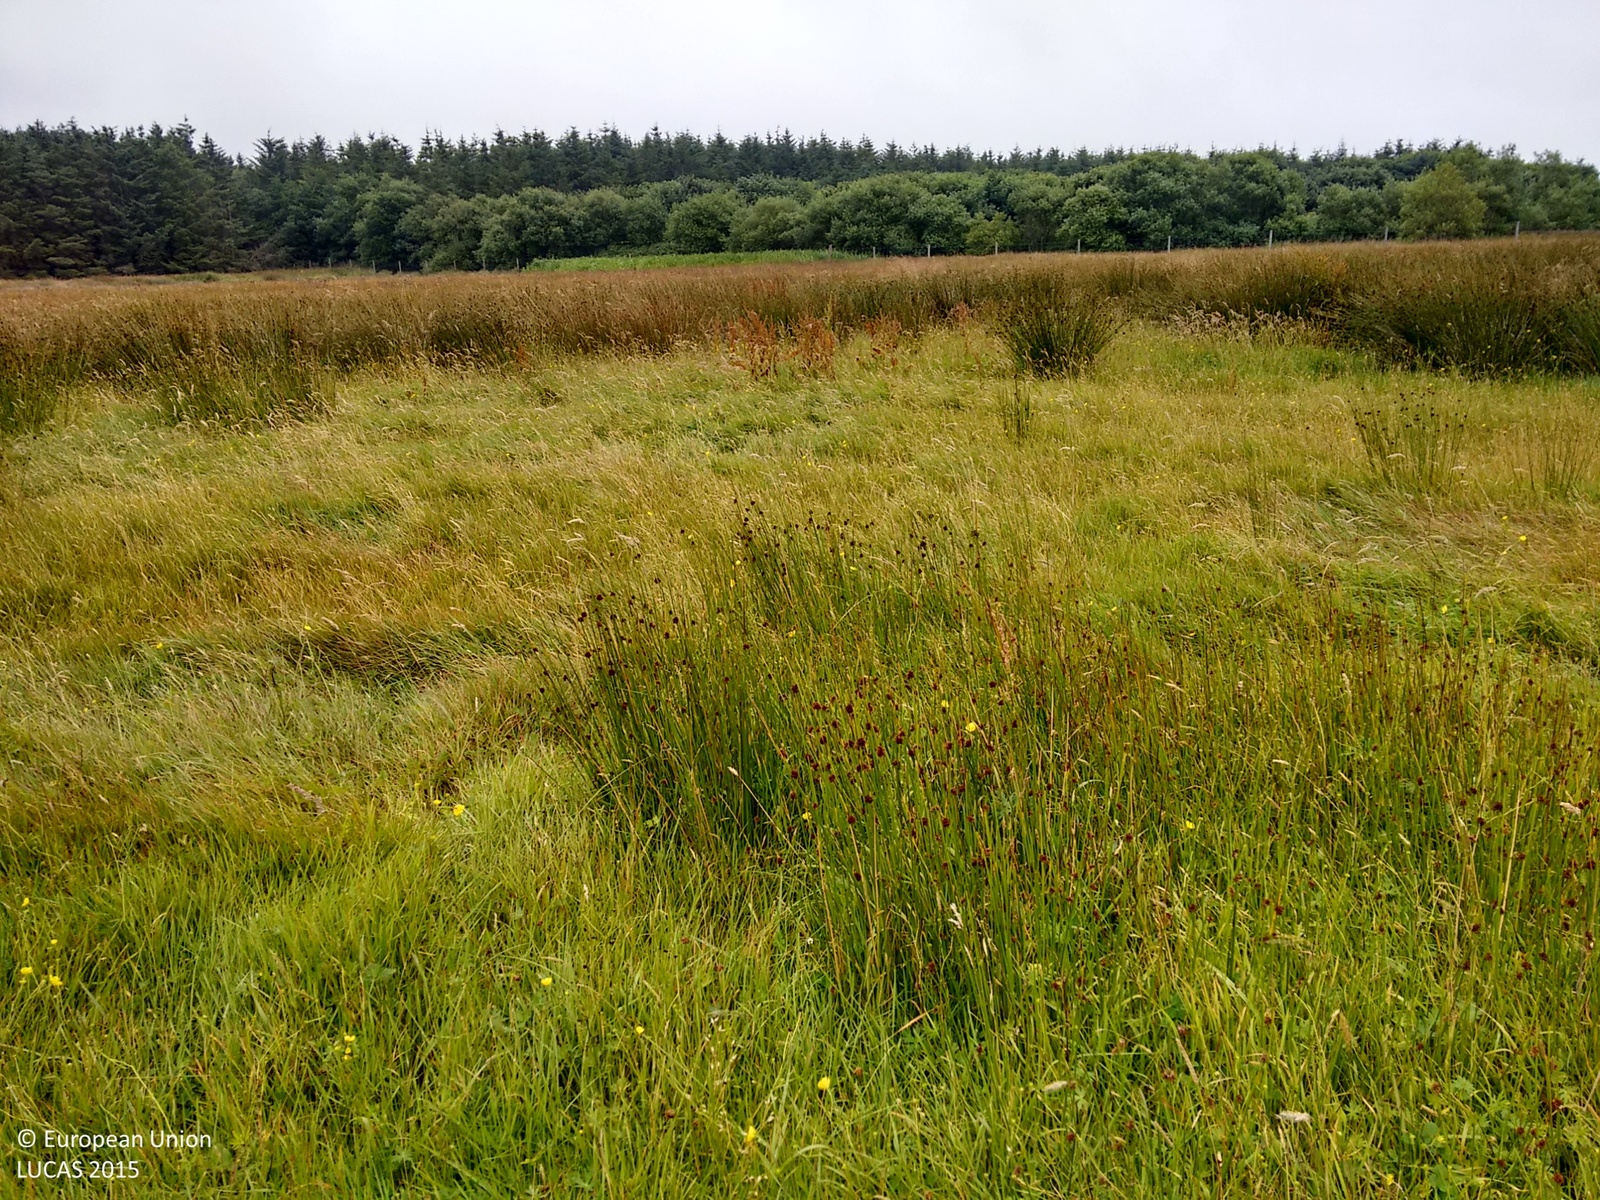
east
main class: Grassland
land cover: Grassland without tree/shrub cover
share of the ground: > 75 %
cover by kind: herbaceous plants 100 %
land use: Agriculture (excluding fallow land and kitchen gardens)
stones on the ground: < 10 %
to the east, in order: Grassland without tree/shrub cover; Peatbogs; Fences; Broadleaved woodland; Tracks; Grassland with sparse tree/shrub cover; Tracks; Spontaneously vegetated surfaces; Other mixed woodland; Spontaneously vegetated surfaces
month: August
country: GB
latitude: 58.4306
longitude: -3.1249
